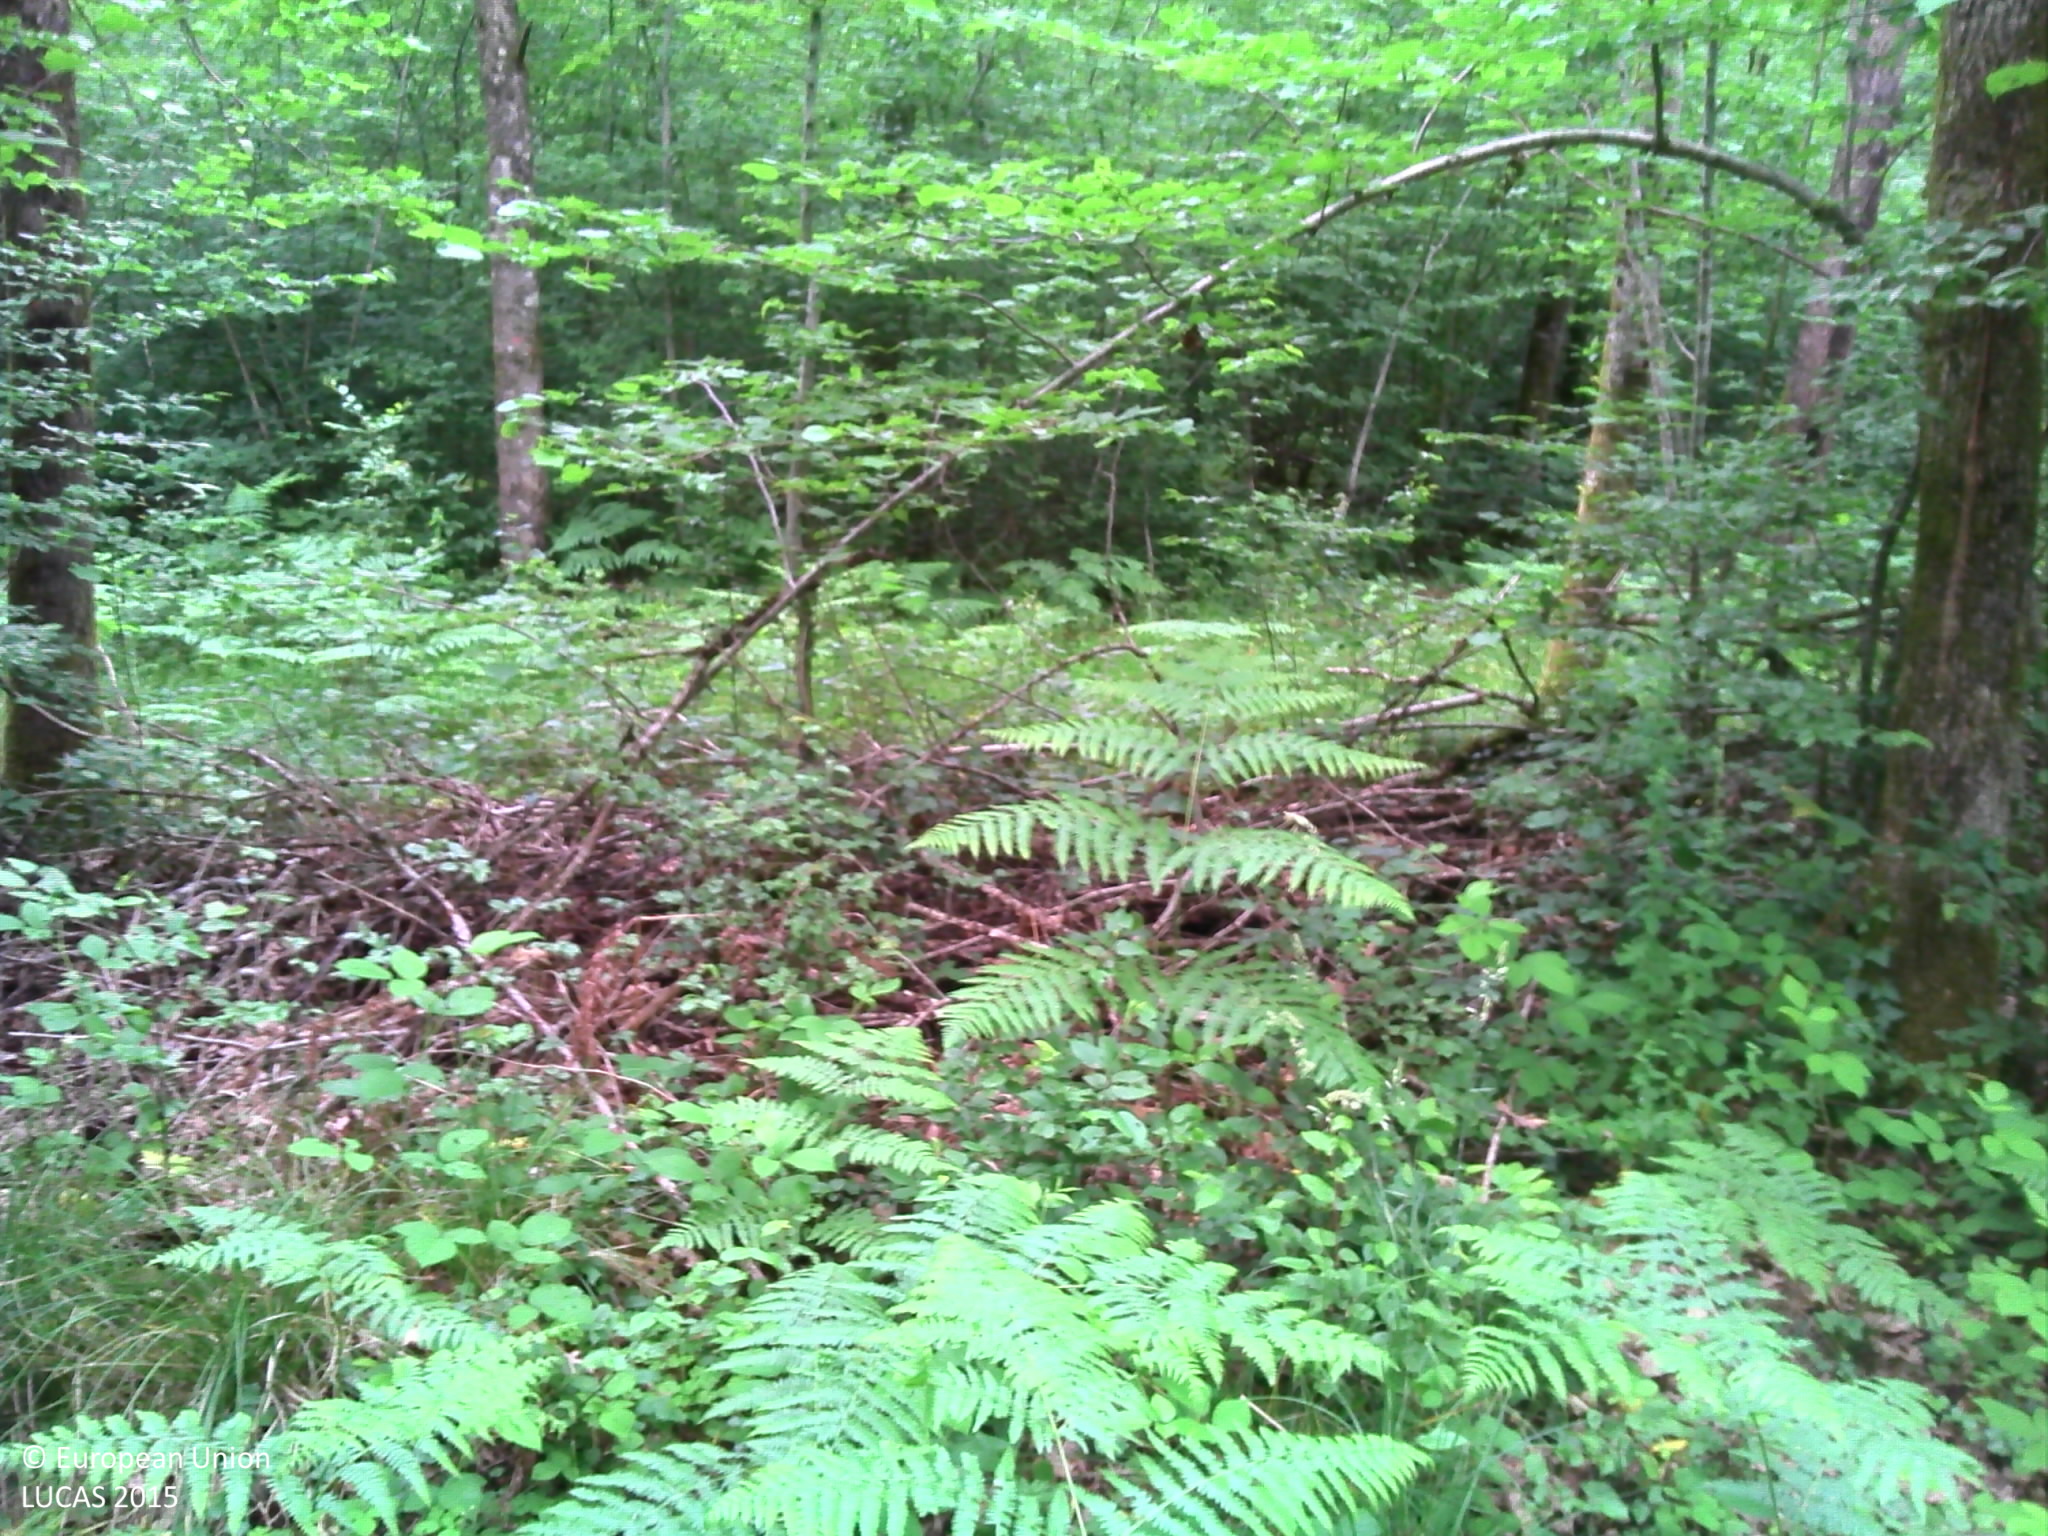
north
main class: Woodland
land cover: Broadleaved woodland
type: mesophytic deciduous forest
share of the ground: > 75 %
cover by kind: broadleaved forest trees 90 %, herbaceous plants 10 %
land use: Forestry
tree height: > 5 m
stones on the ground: < 10 %
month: June
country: FR
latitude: 47.8004
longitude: 6.2761
